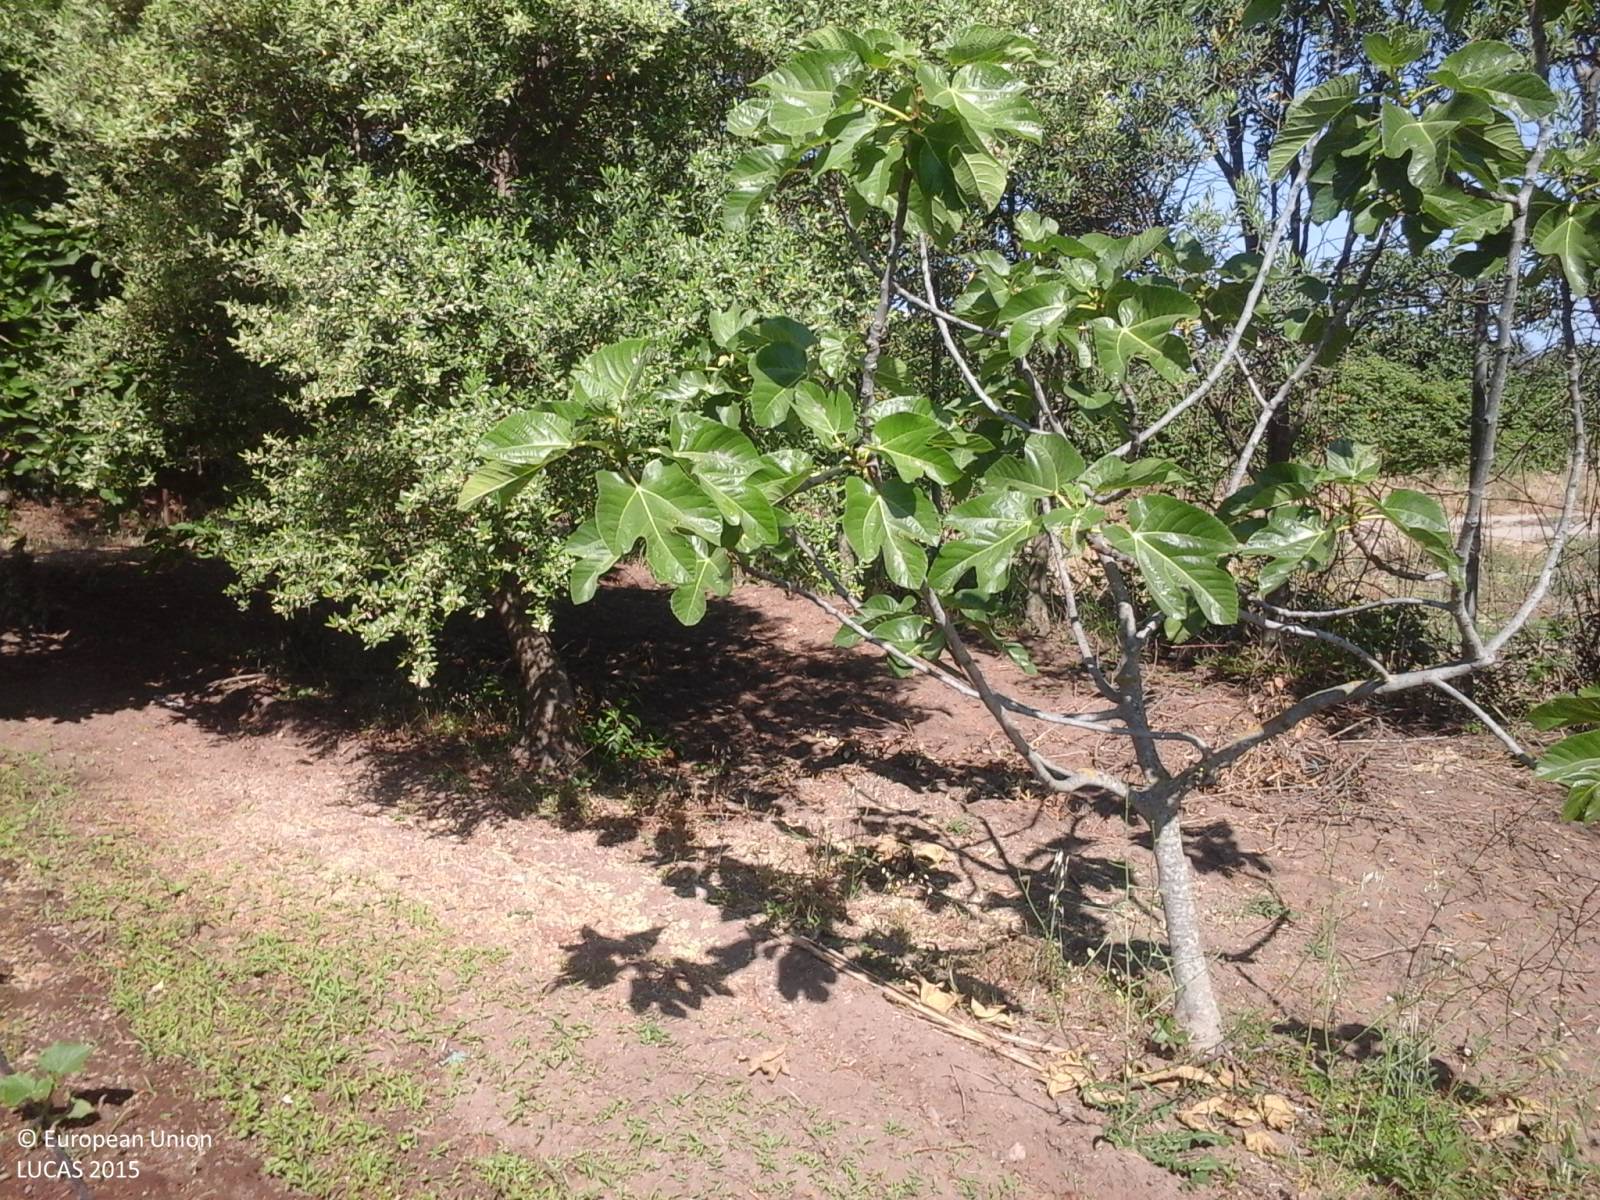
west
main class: Cropland
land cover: Other citrus fruit
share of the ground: < 10 %
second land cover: Other fresh vegetables
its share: < 10 %
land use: Agriculture (excluding fallow land and kitchen gardens)
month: June
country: IT
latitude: 40.9116
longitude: 8.8064
